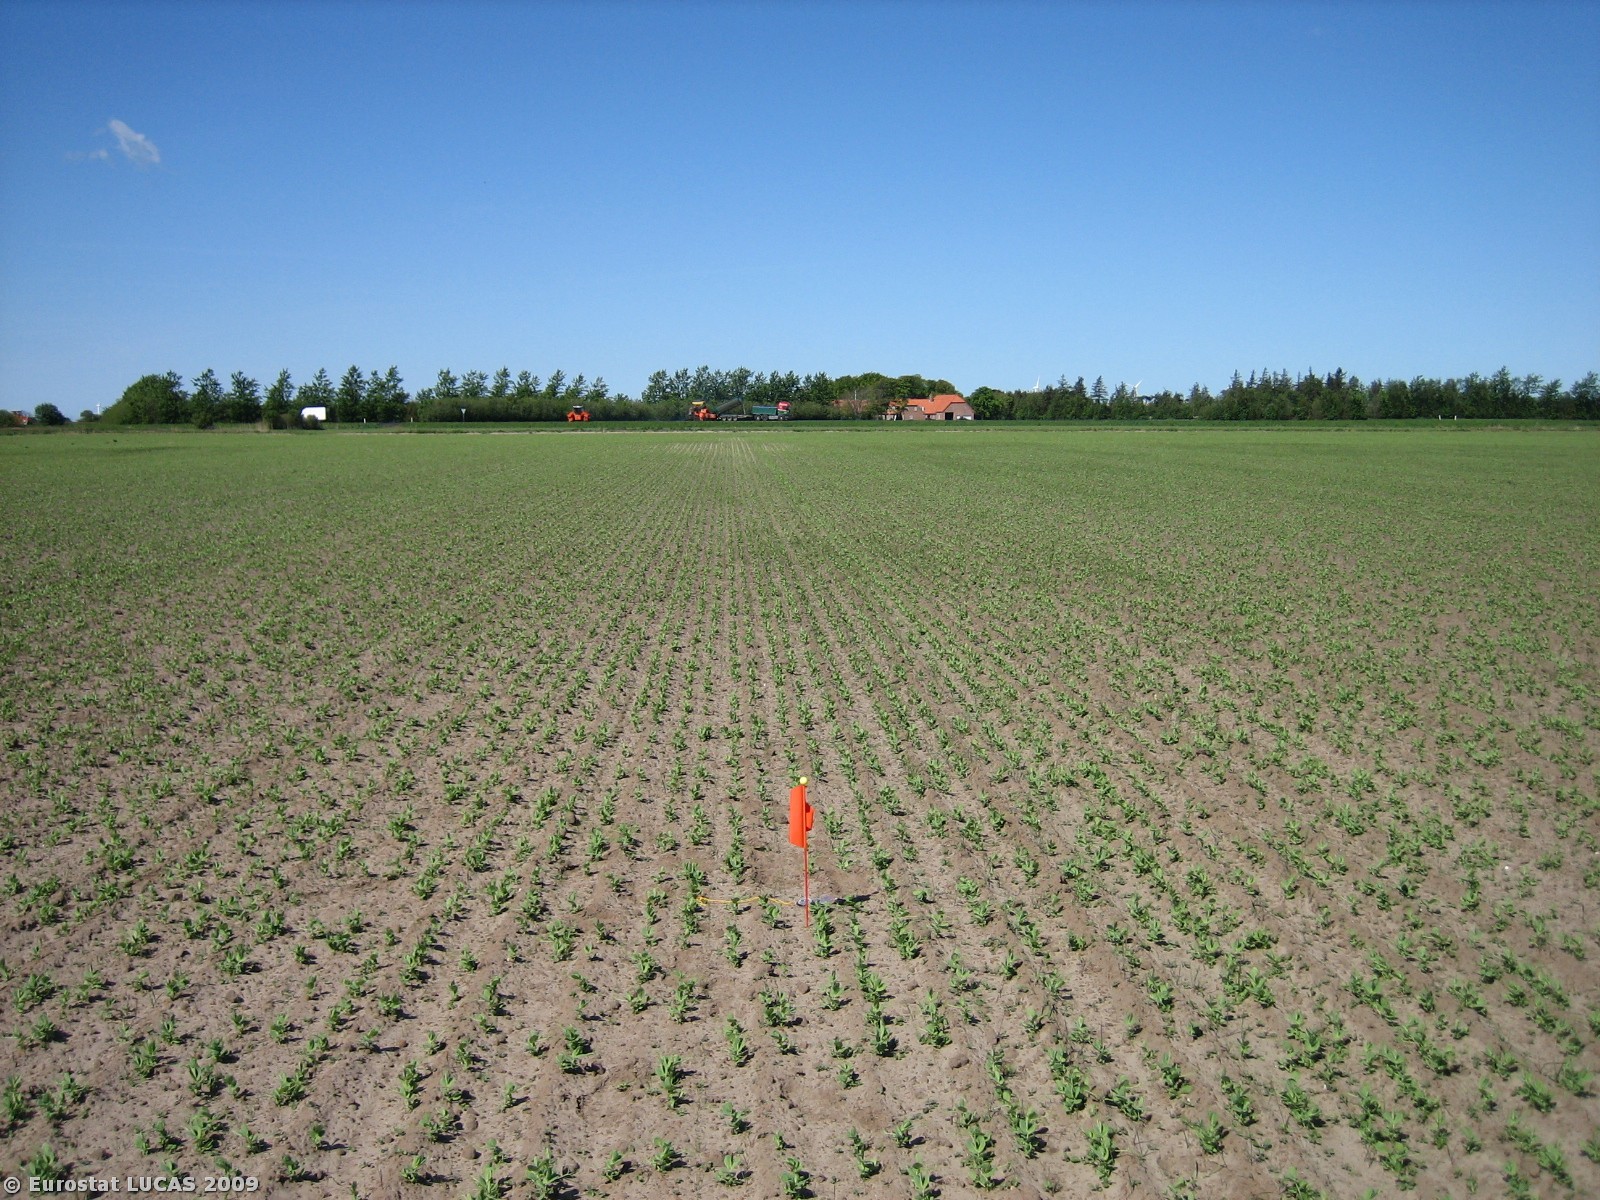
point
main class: Cropland
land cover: Dry pulses
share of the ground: 25 - 50 %
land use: Agriculture (excluding fallow land and kitchen gardens)
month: May
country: DK
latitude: 56.2849
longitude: 8.3380
